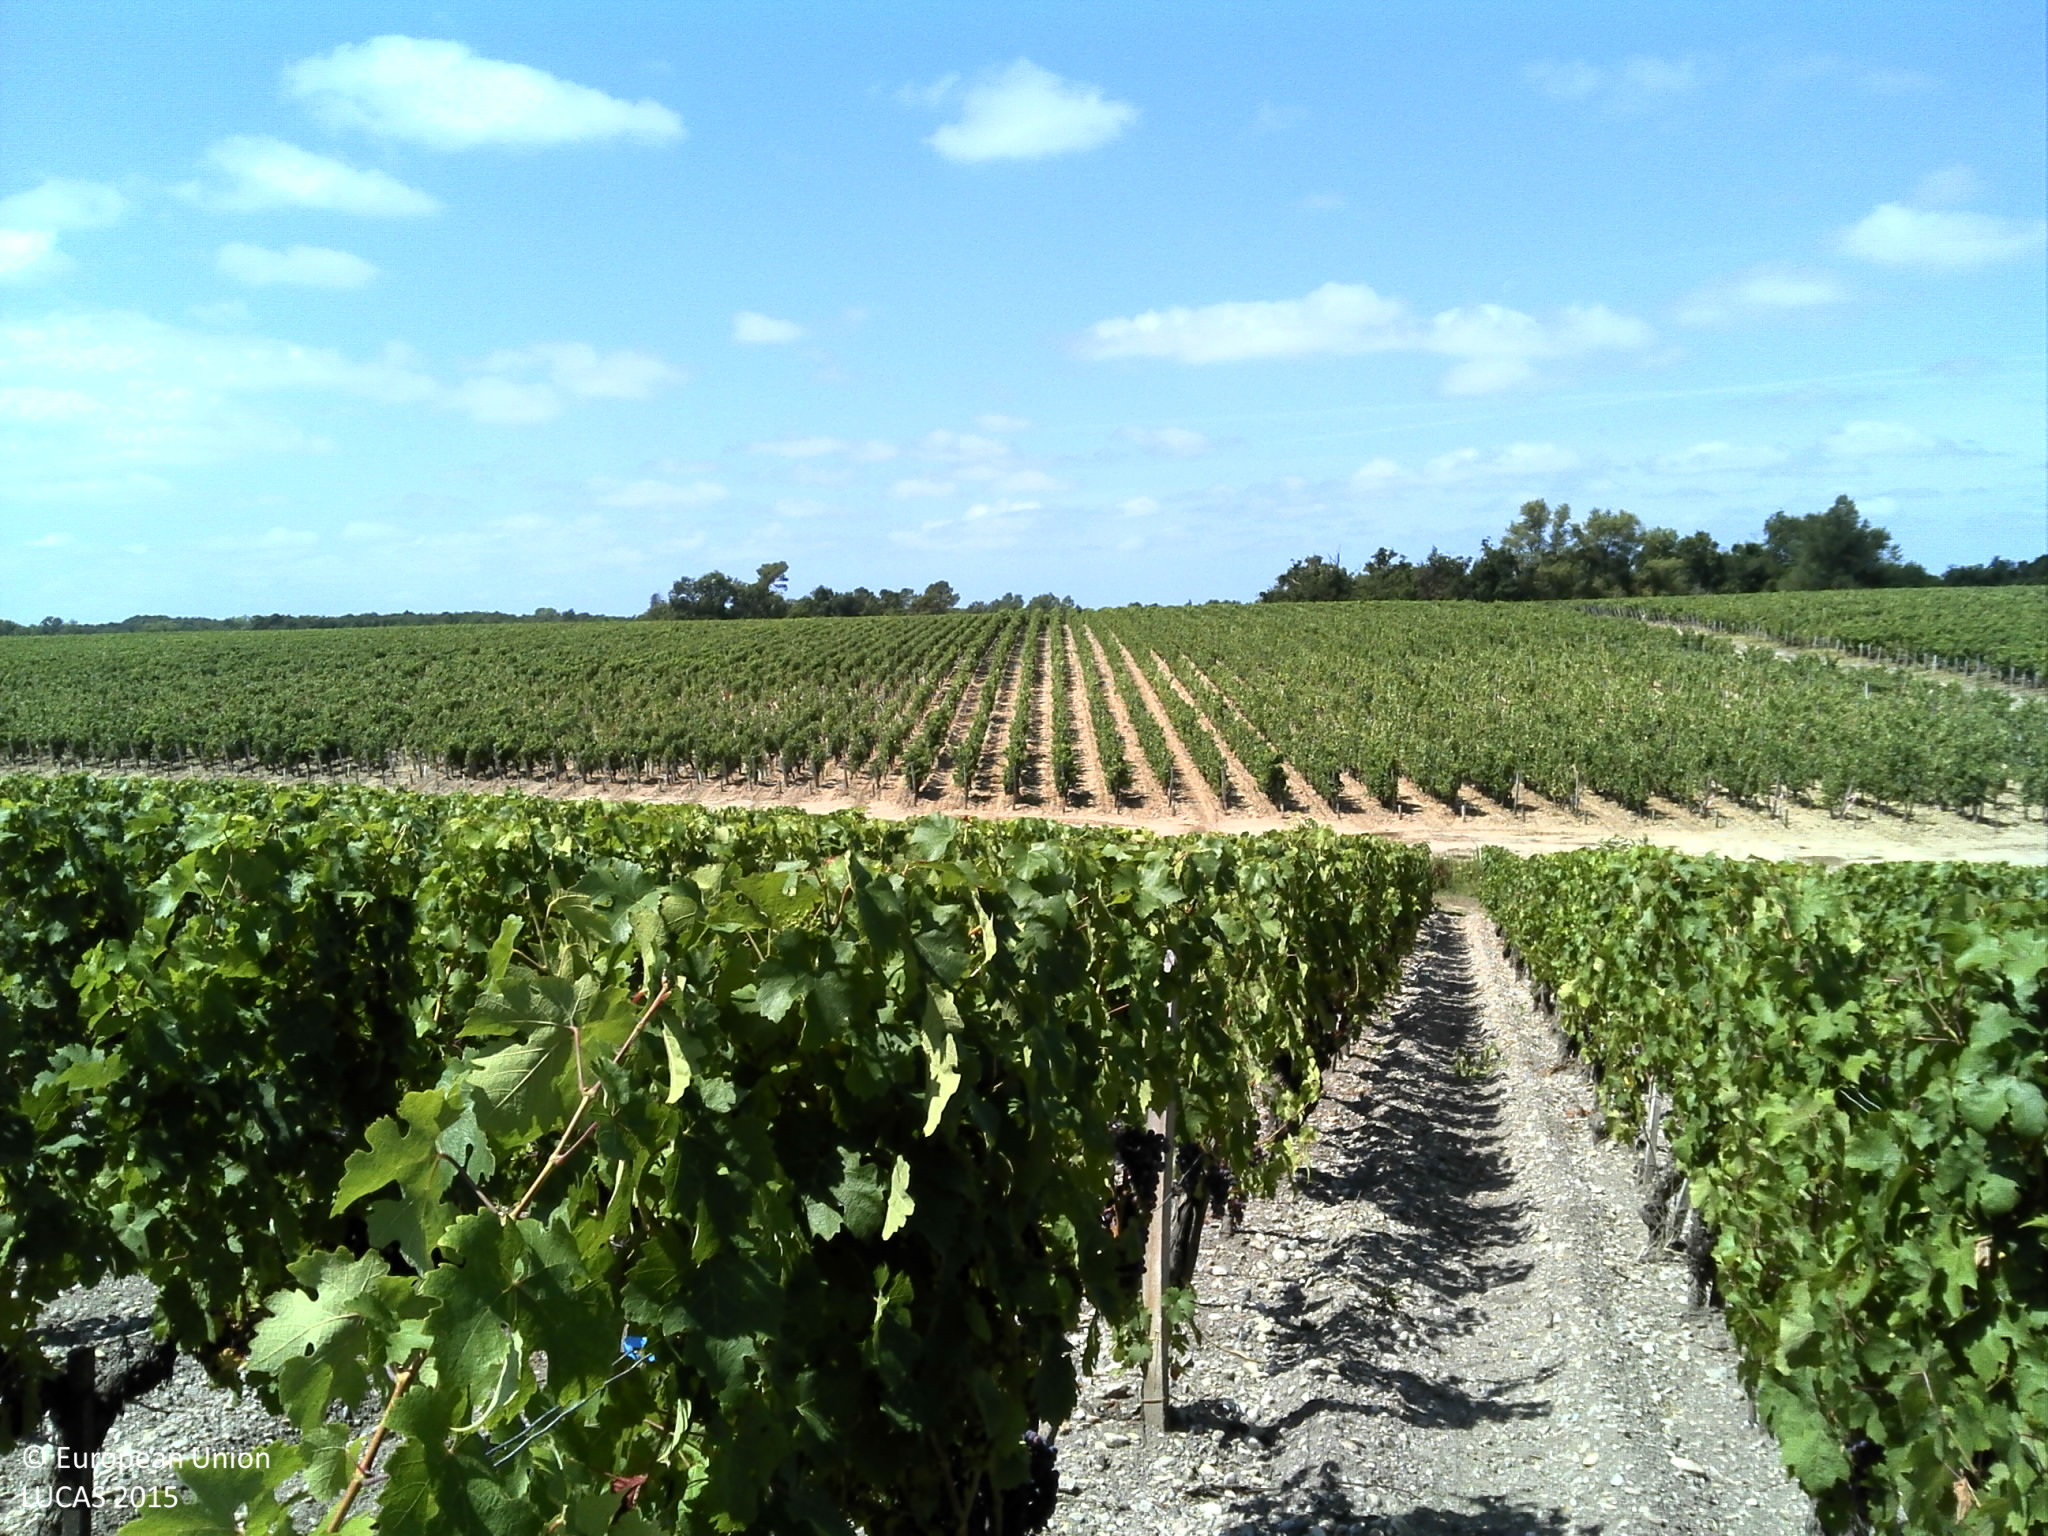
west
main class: Cropland
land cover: Vineyards
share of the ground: 25 - 50 %
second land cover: Other bare soil
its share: > 75 %
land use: Agriculture (excluding fallow land and kitchen gardens)
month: August
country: FR
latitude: 45.1873
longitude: -0.7772
